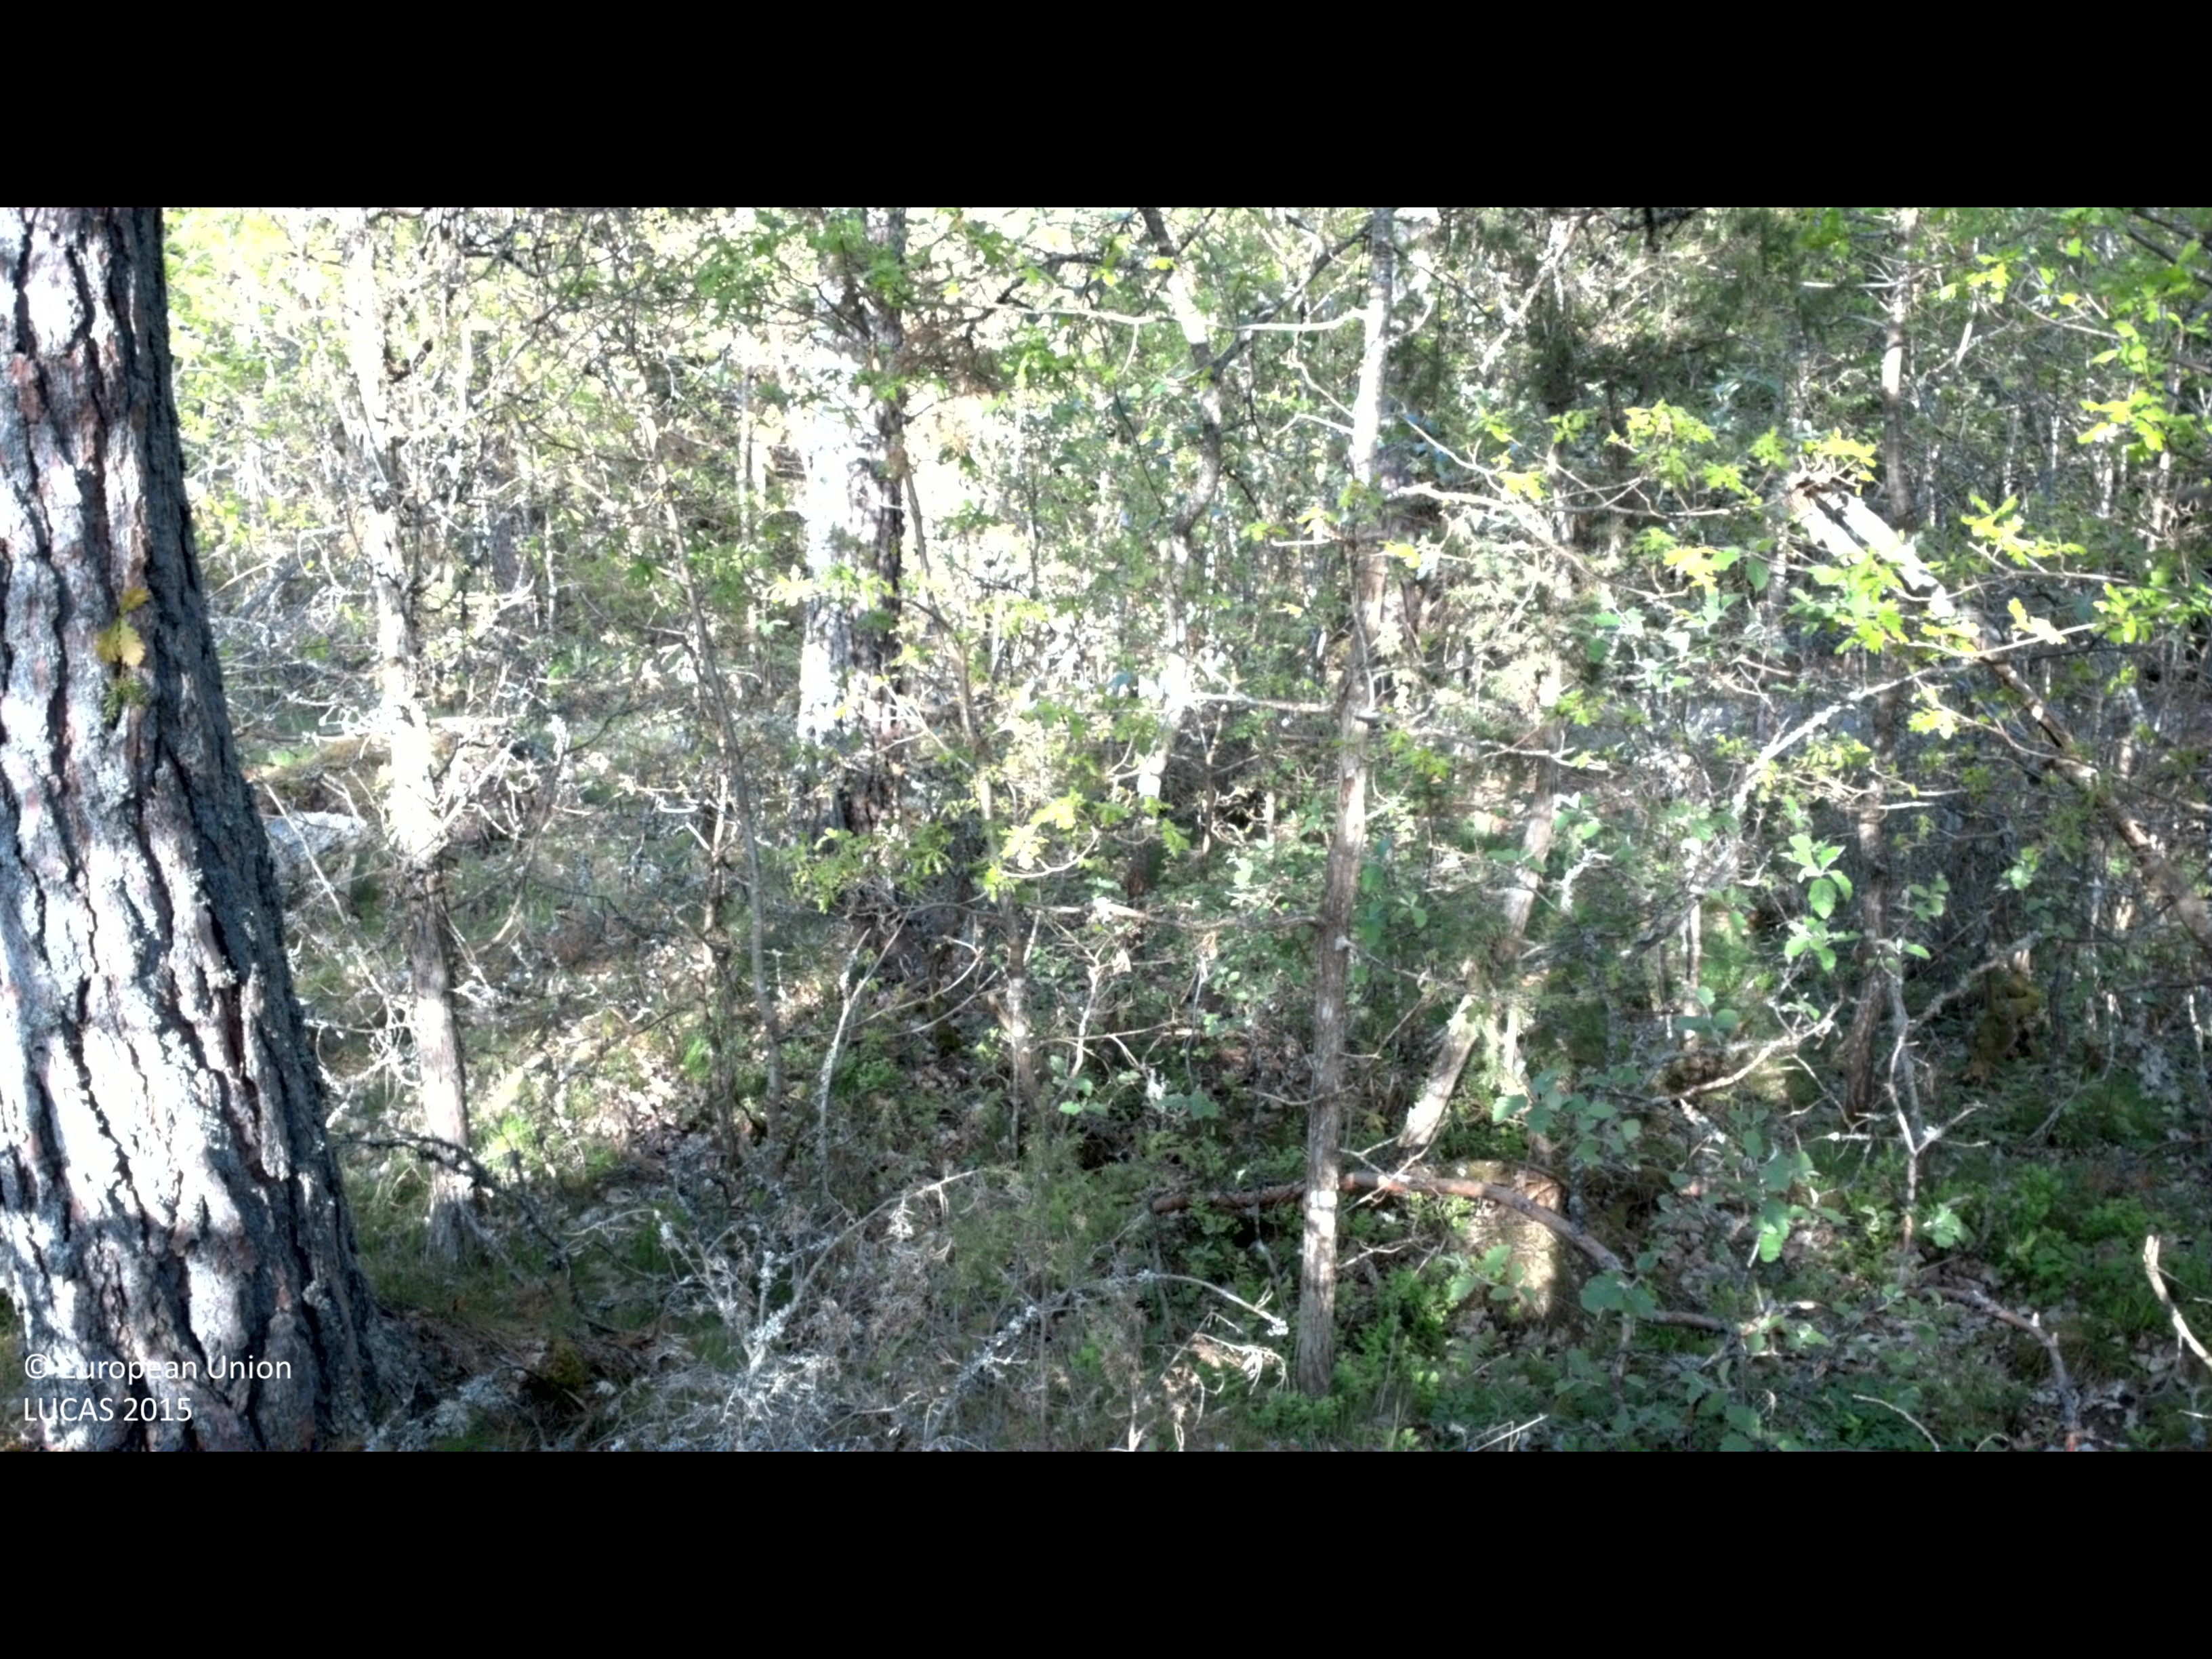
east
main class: Woodland
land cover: Pine dominated mixed woodland
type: boreal forest
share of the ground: > 75 %
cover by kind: broadleaved forest trees 60 %, coniferous forest trees 20 %, herbaceous plants 15 %, shrubs 5 %
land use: Forestry
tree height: > 5 m
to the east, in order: Pine dominated mixed woodland; Tracks; Spruce dominated coniferous woodland; Electric lines; Spruce dominated mixed woodland; Spruce dominated coniferous woodland; Broadleaved woodland
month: May
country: SE
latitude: 57.3922
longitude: 16.1713
